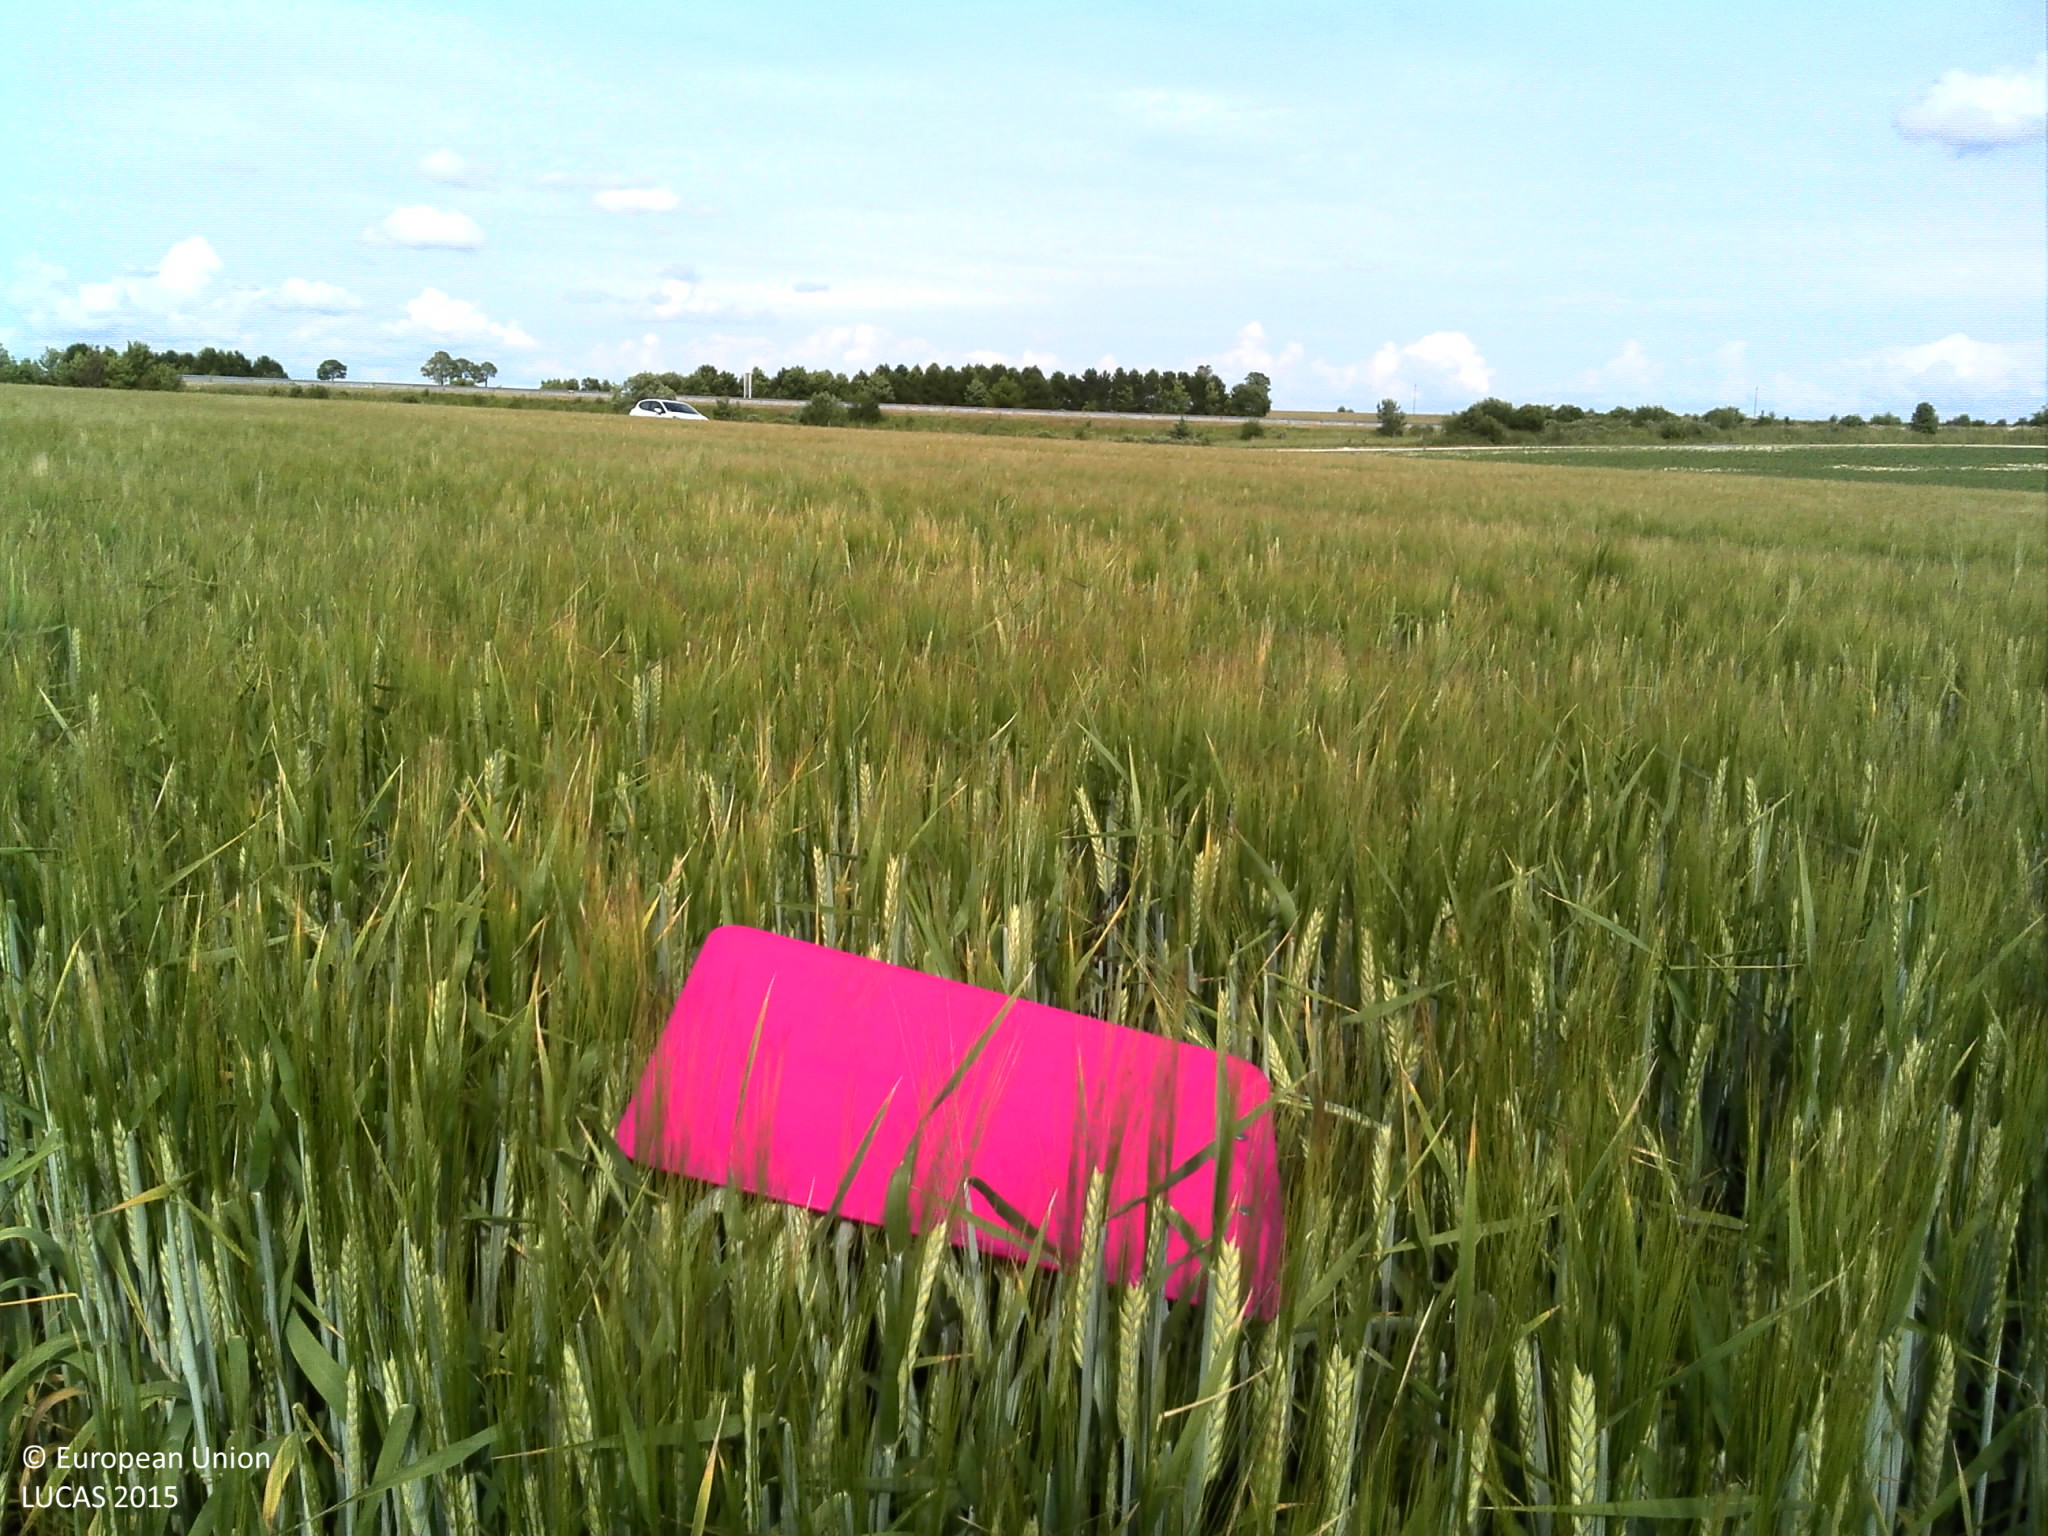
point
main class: Cropland
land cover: Barley
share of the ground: > 75 %
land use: Agriculture (excluding fallow land and kitchen gardens)
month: June
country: FR
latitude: 48.6467
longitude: 4.1733
